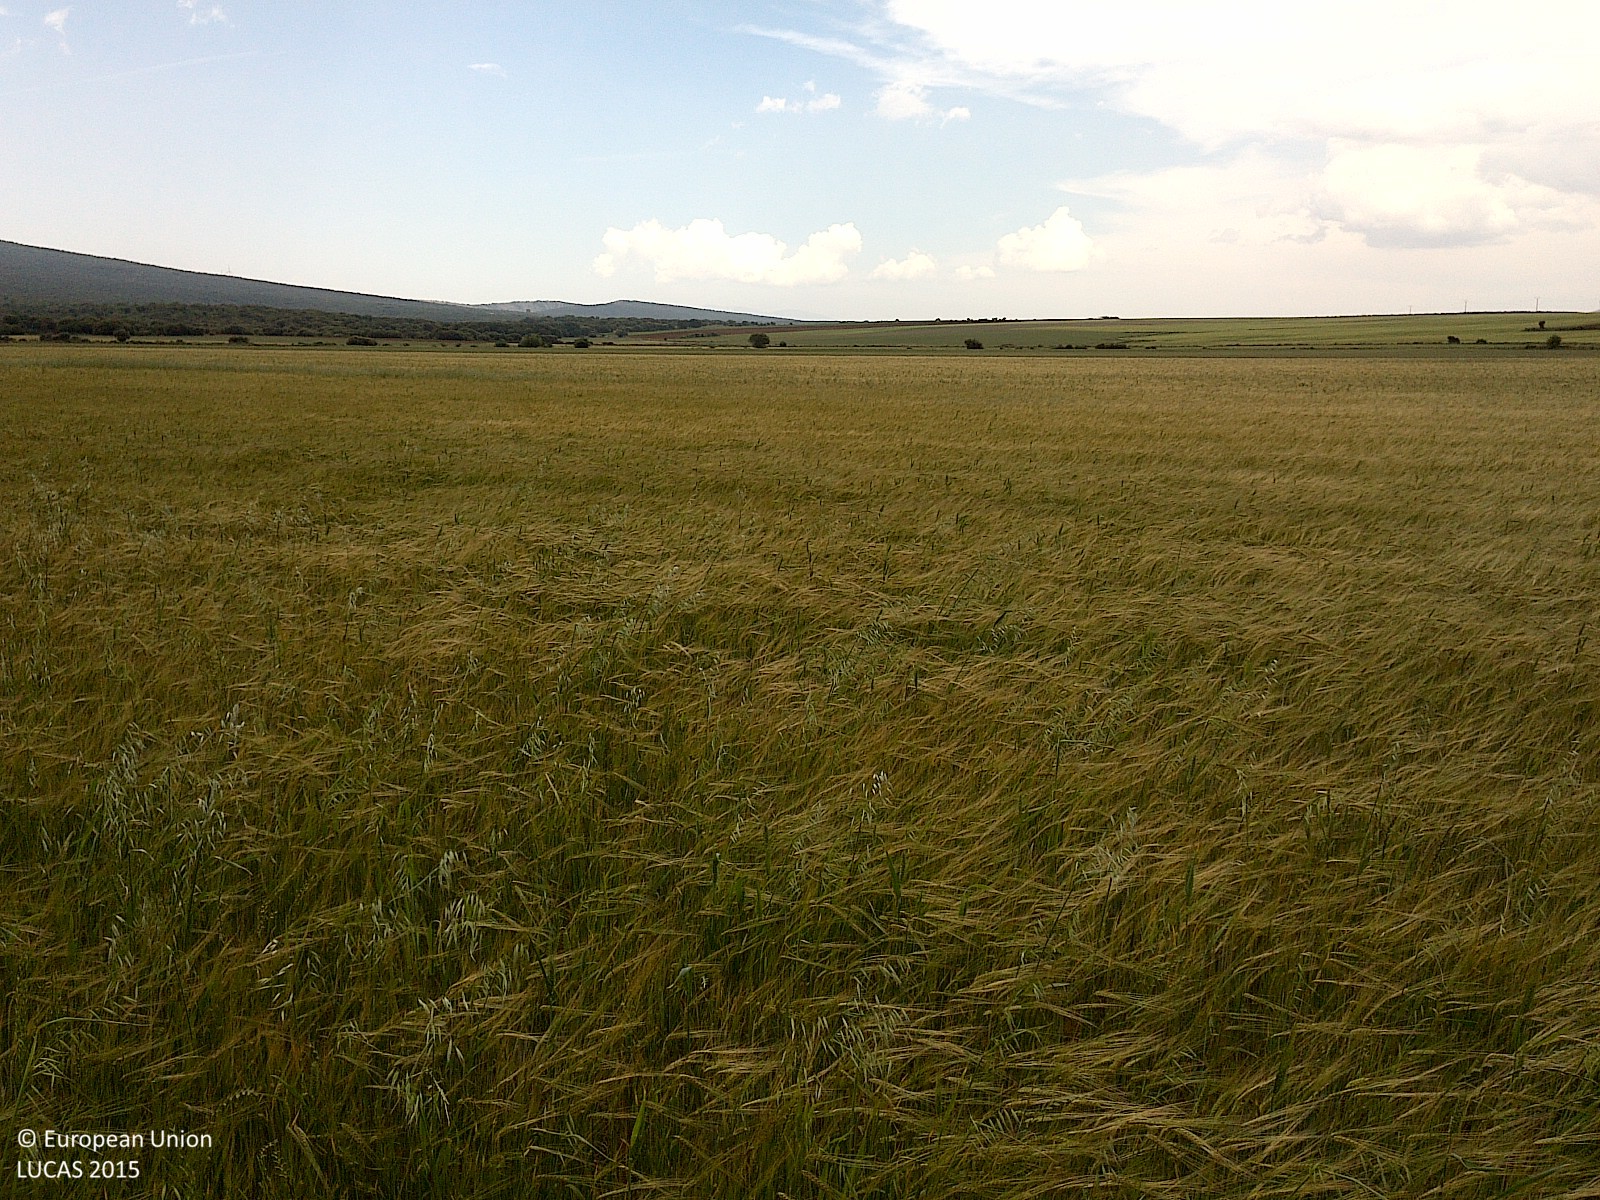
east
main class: Cropland
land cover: Barley
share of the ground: > 75 %
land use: Agriculture (excluding fallow land and kitchen gardens)
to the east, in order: Barley; Common wheat
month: May
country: ES
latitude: 41.8097
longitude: -2.3023
